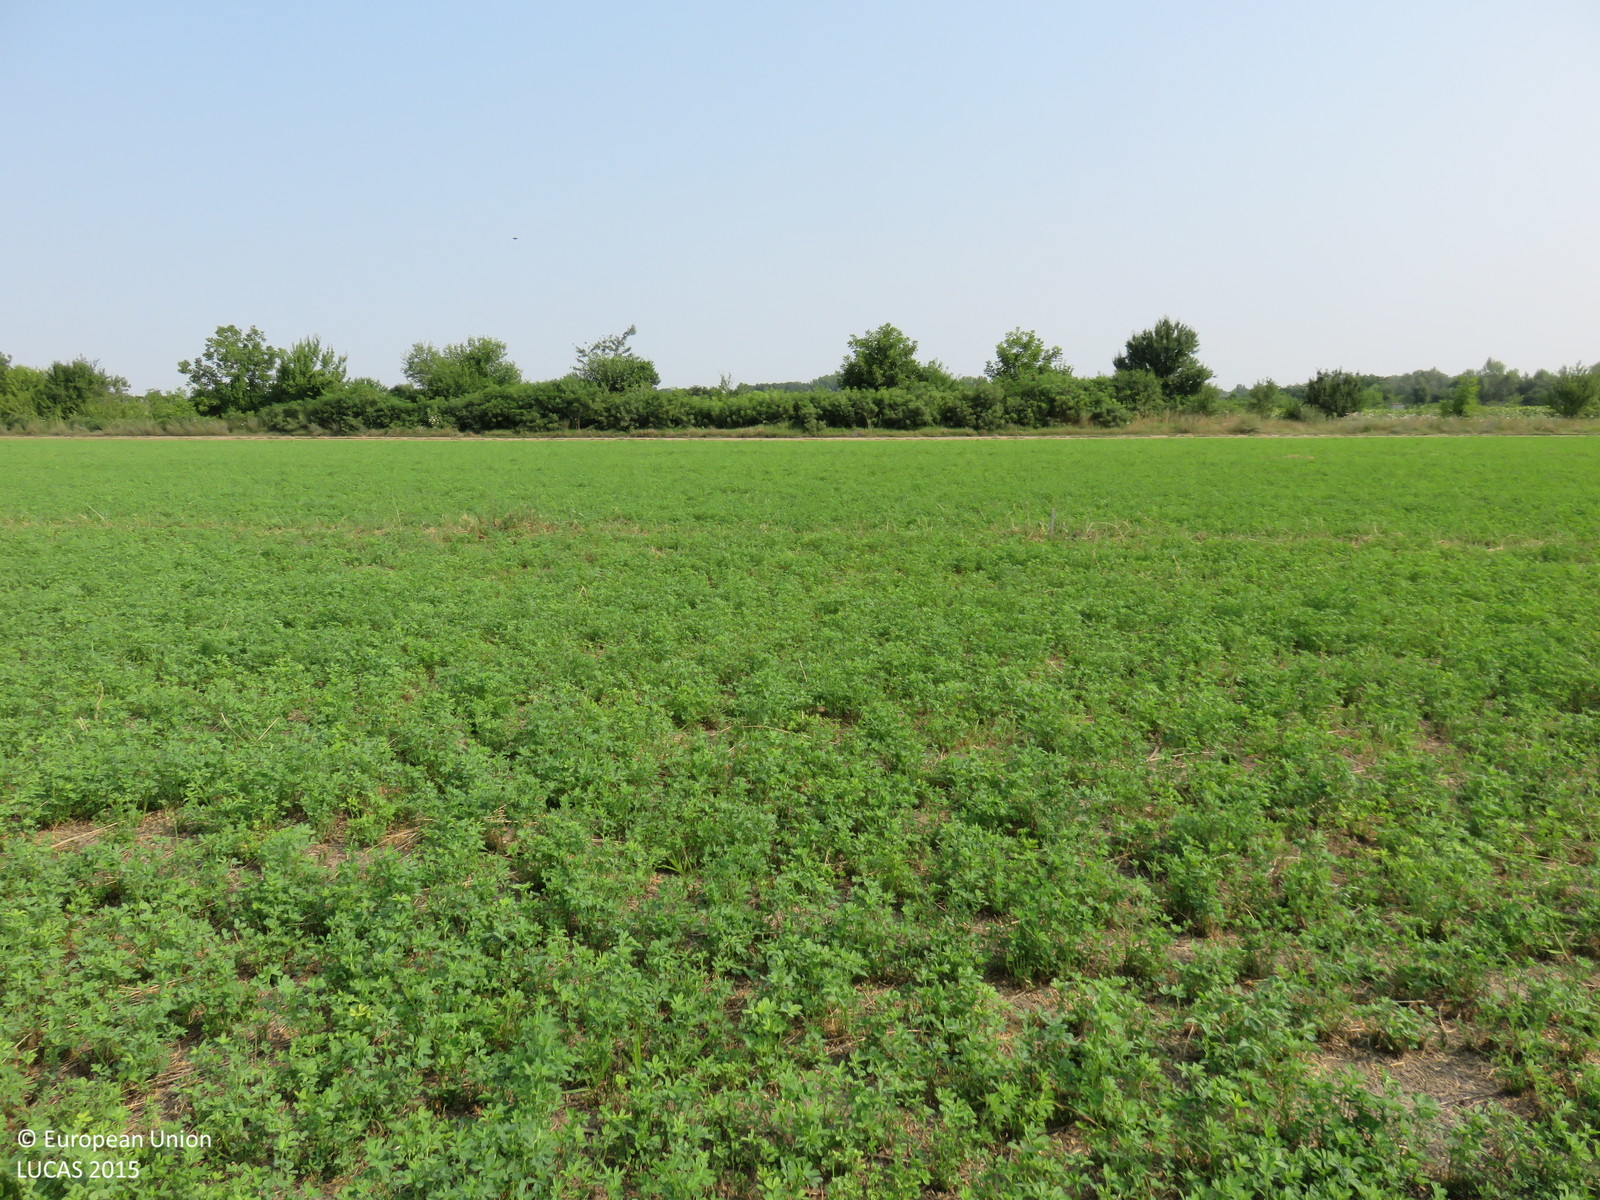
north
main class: Cropland
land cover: Lucerne
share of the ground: > 75 %
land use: Agriculture (excluding fallow land and kitchen gardens)
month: July
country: BG
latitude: 43.6322
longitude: 25.1600
